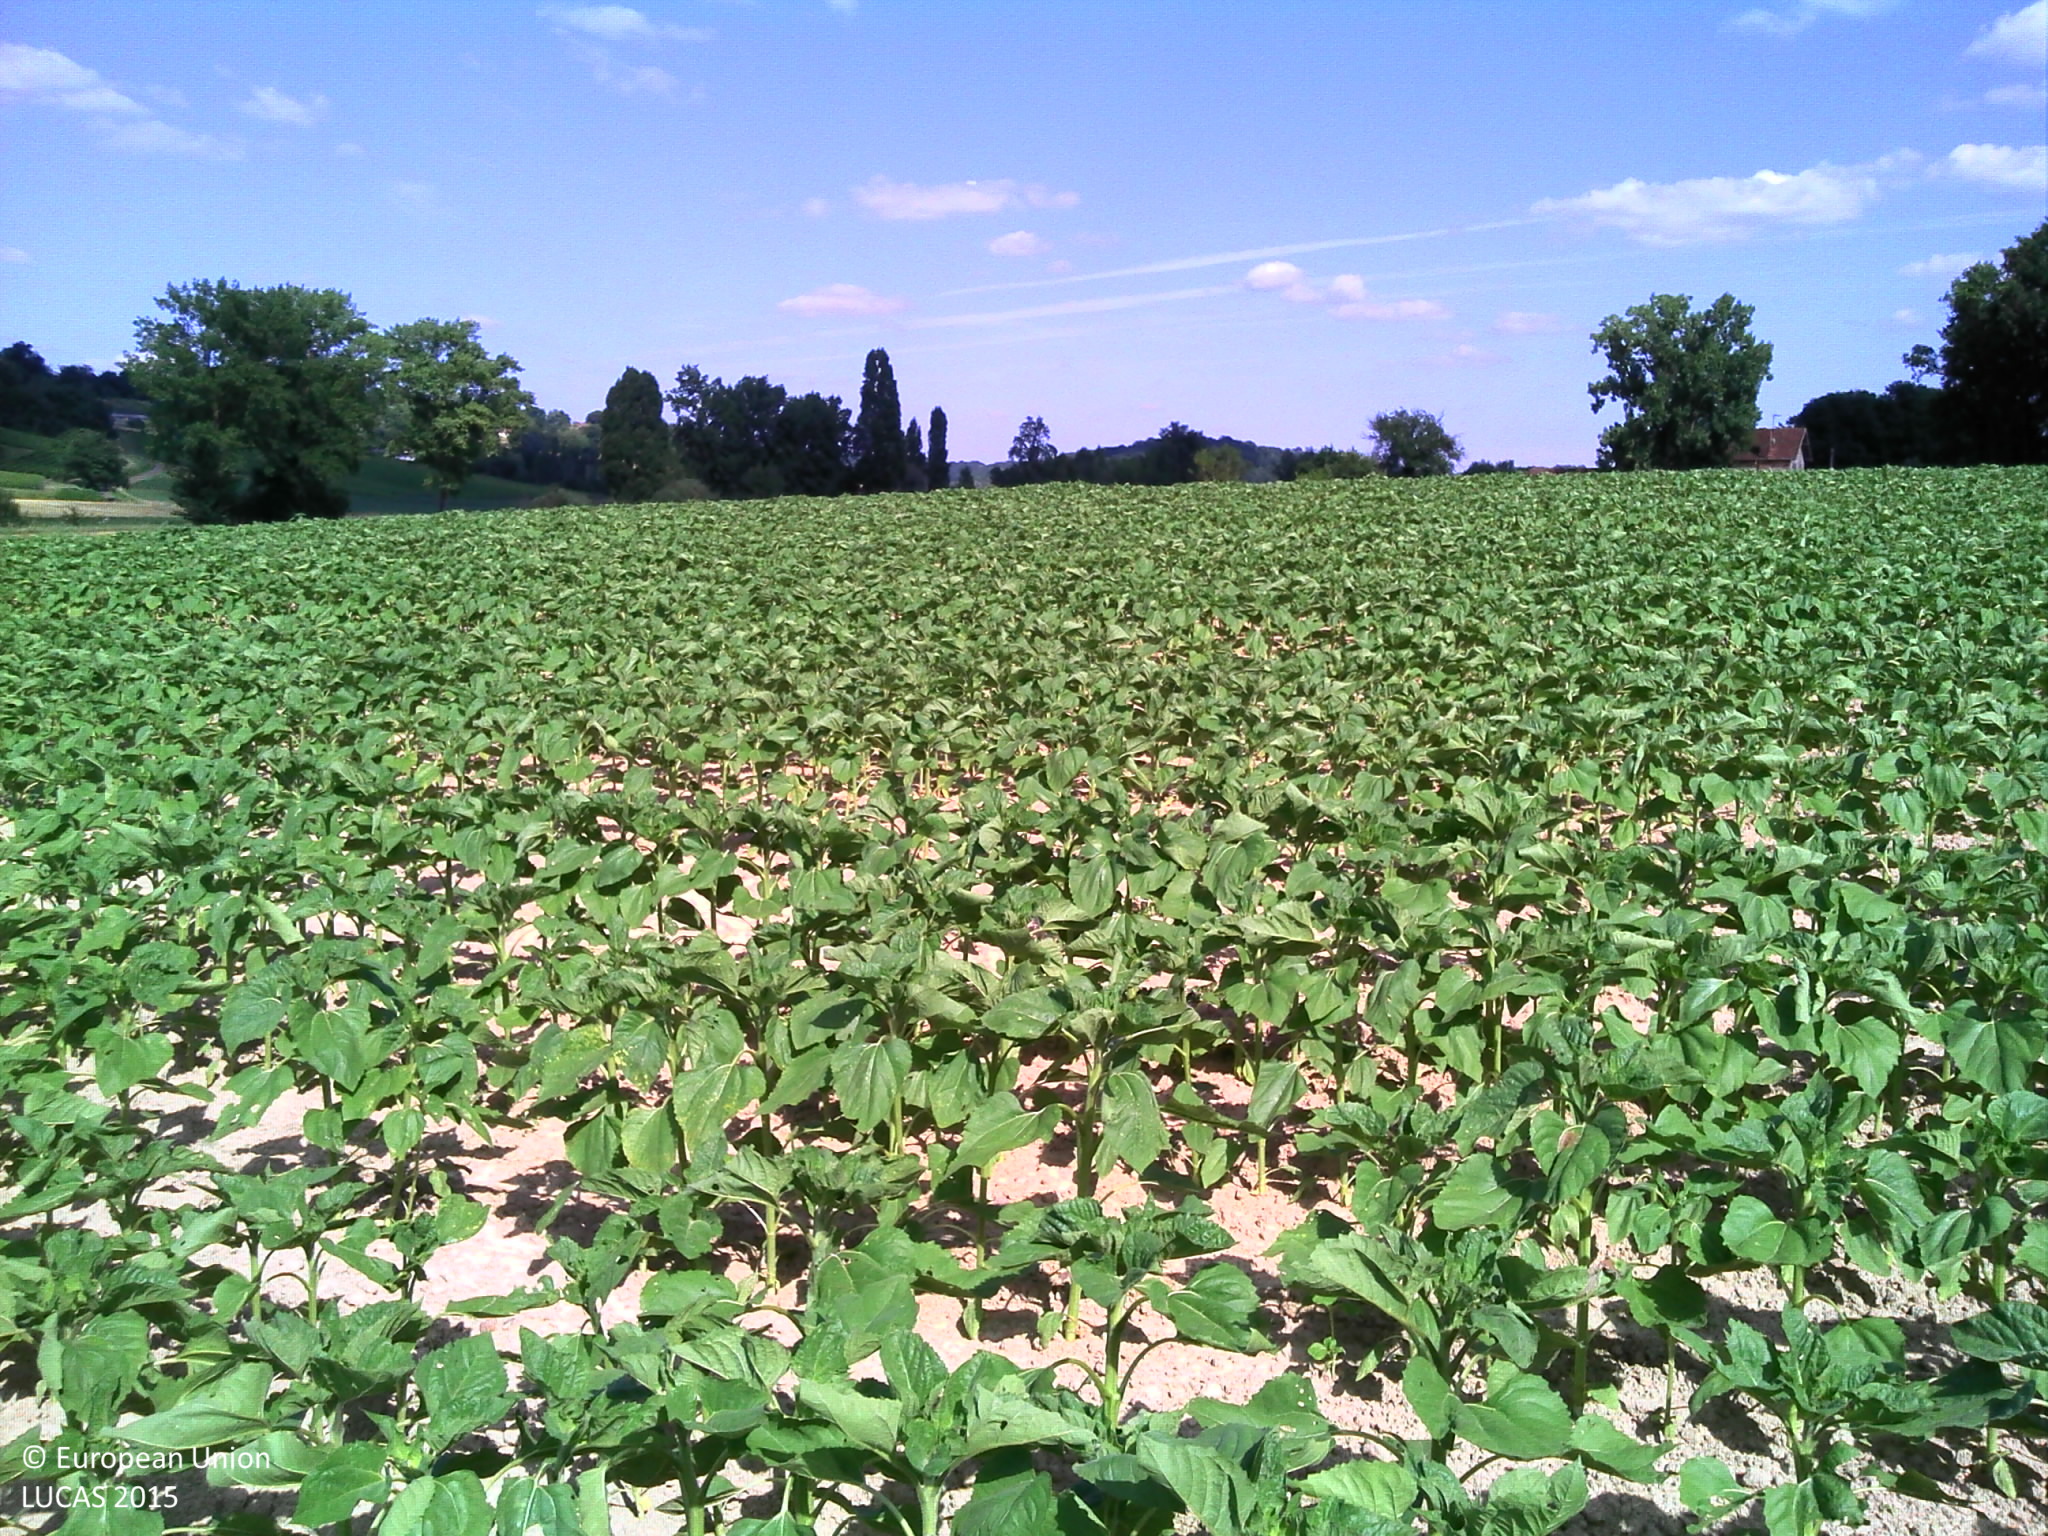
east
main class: Cropland
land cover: Sunflower
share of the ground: 50 - 75 %
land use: Agriculture (excluding fallow land and kitchen gardens)
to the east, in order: Sunflower; Grassland without tree/shrub cover; Ditches and canals; Grassland without tree/shrub cover; Grass margins; Rivers and streams
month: June
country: FR
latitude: 43.6745
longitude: -0.4661
